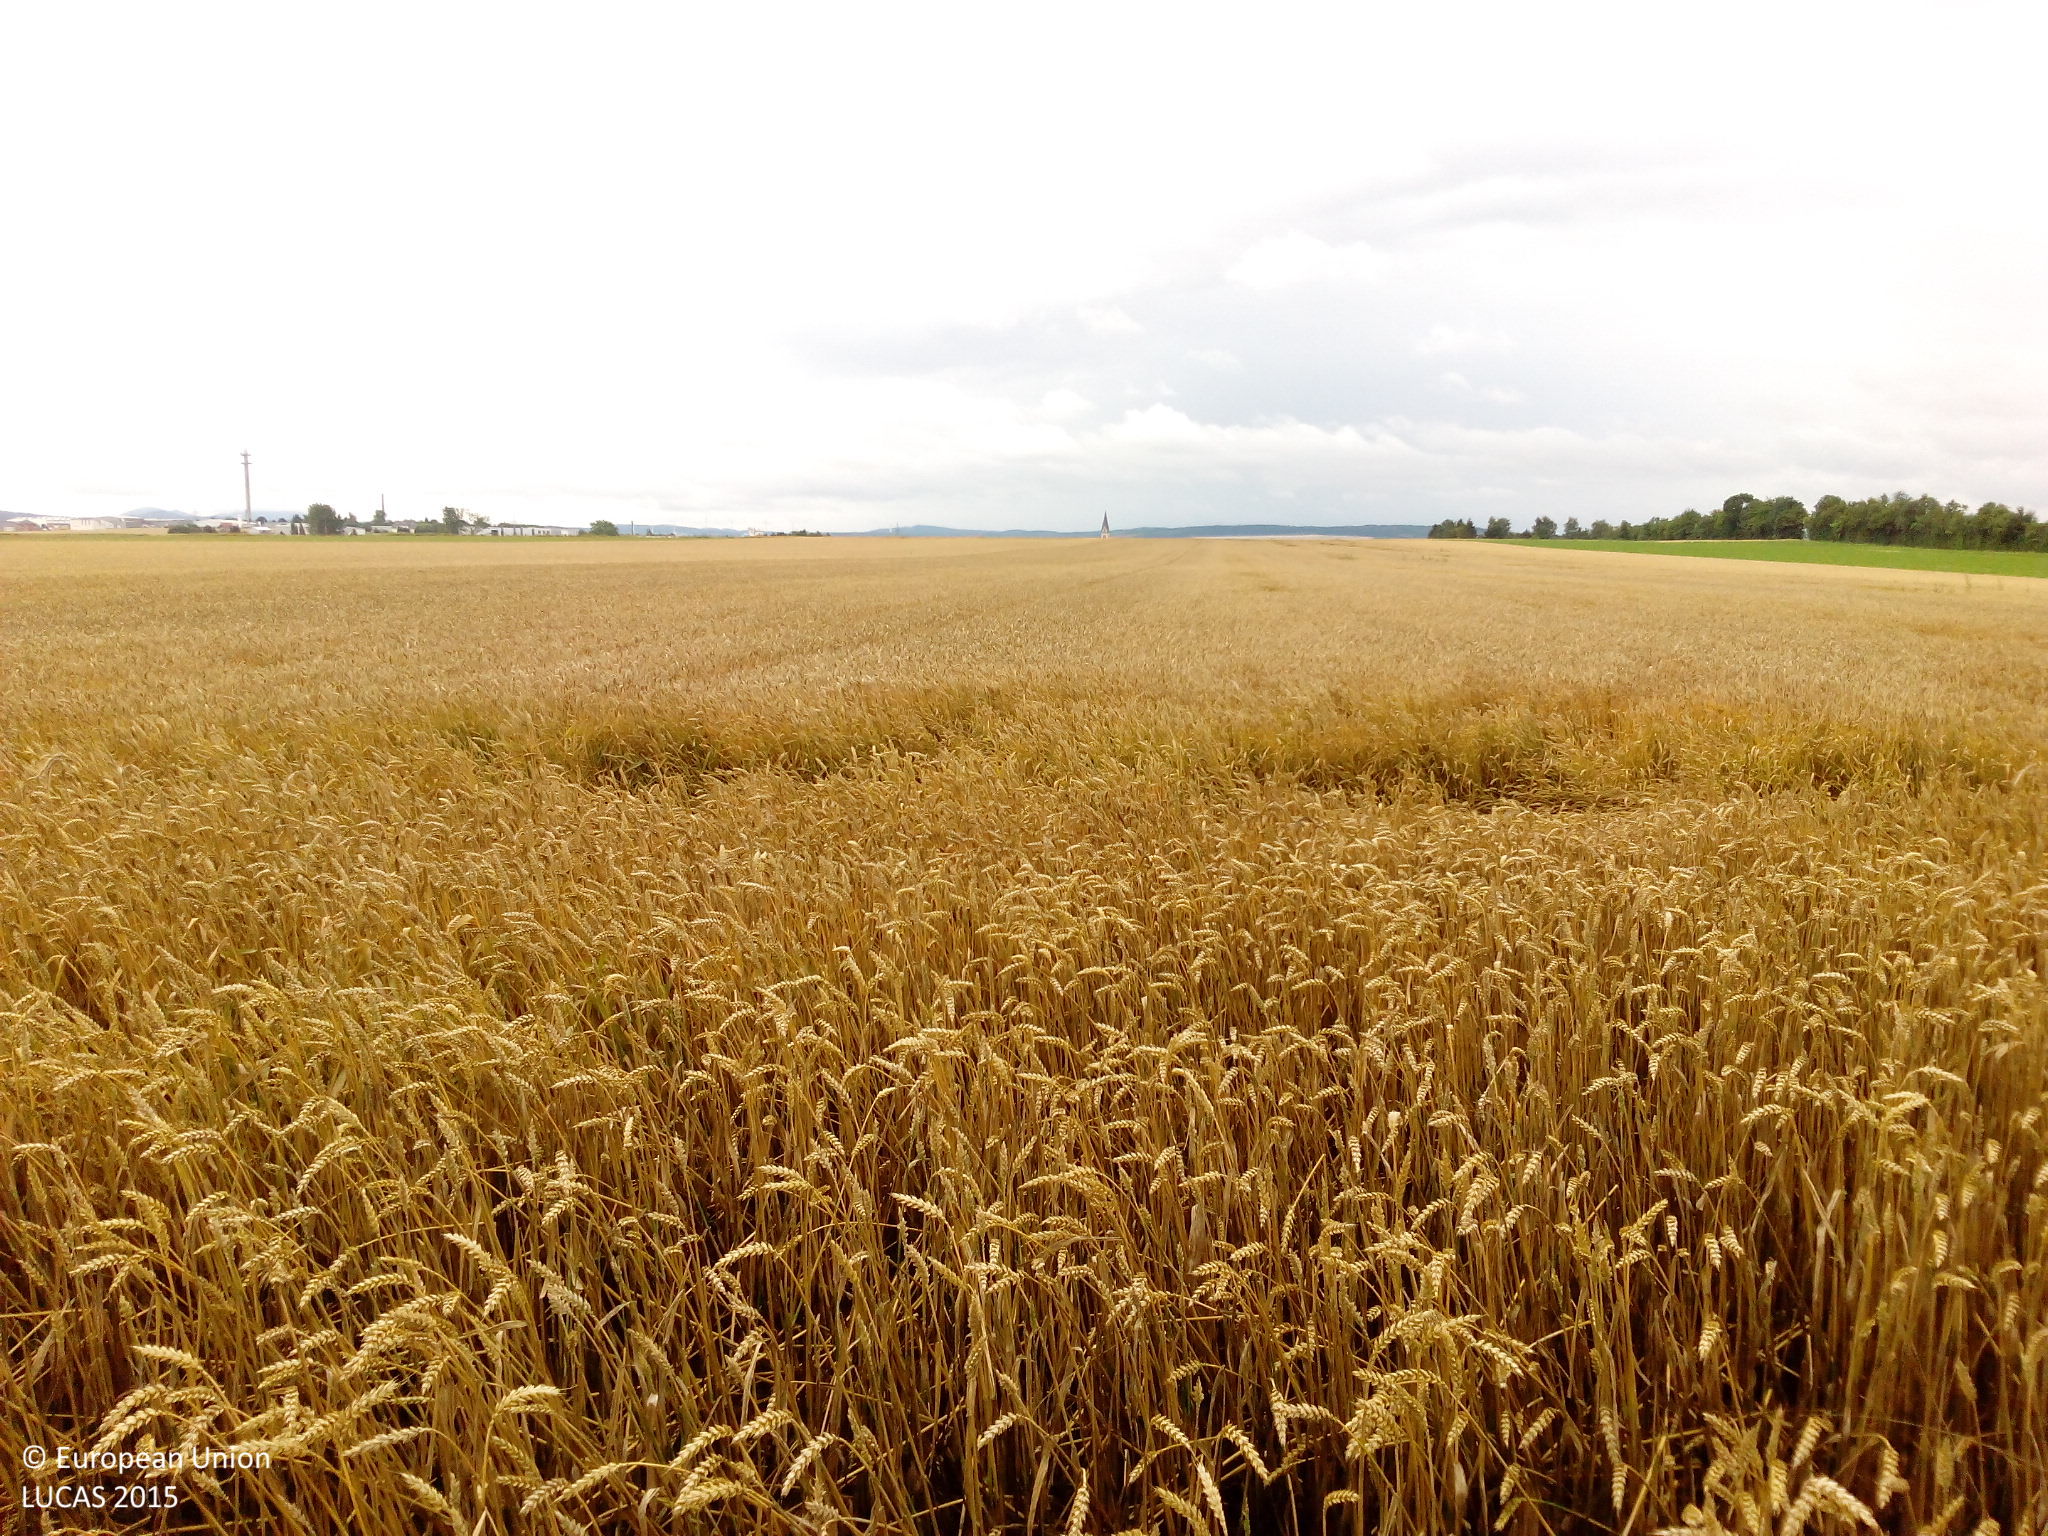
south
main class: Cropland
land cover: Common wheat
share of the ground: > 75 %
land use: Agriculture (excluding fallow land and kitchen gardens)
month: July
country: DE
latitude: 51.5116
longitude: 9.1501
